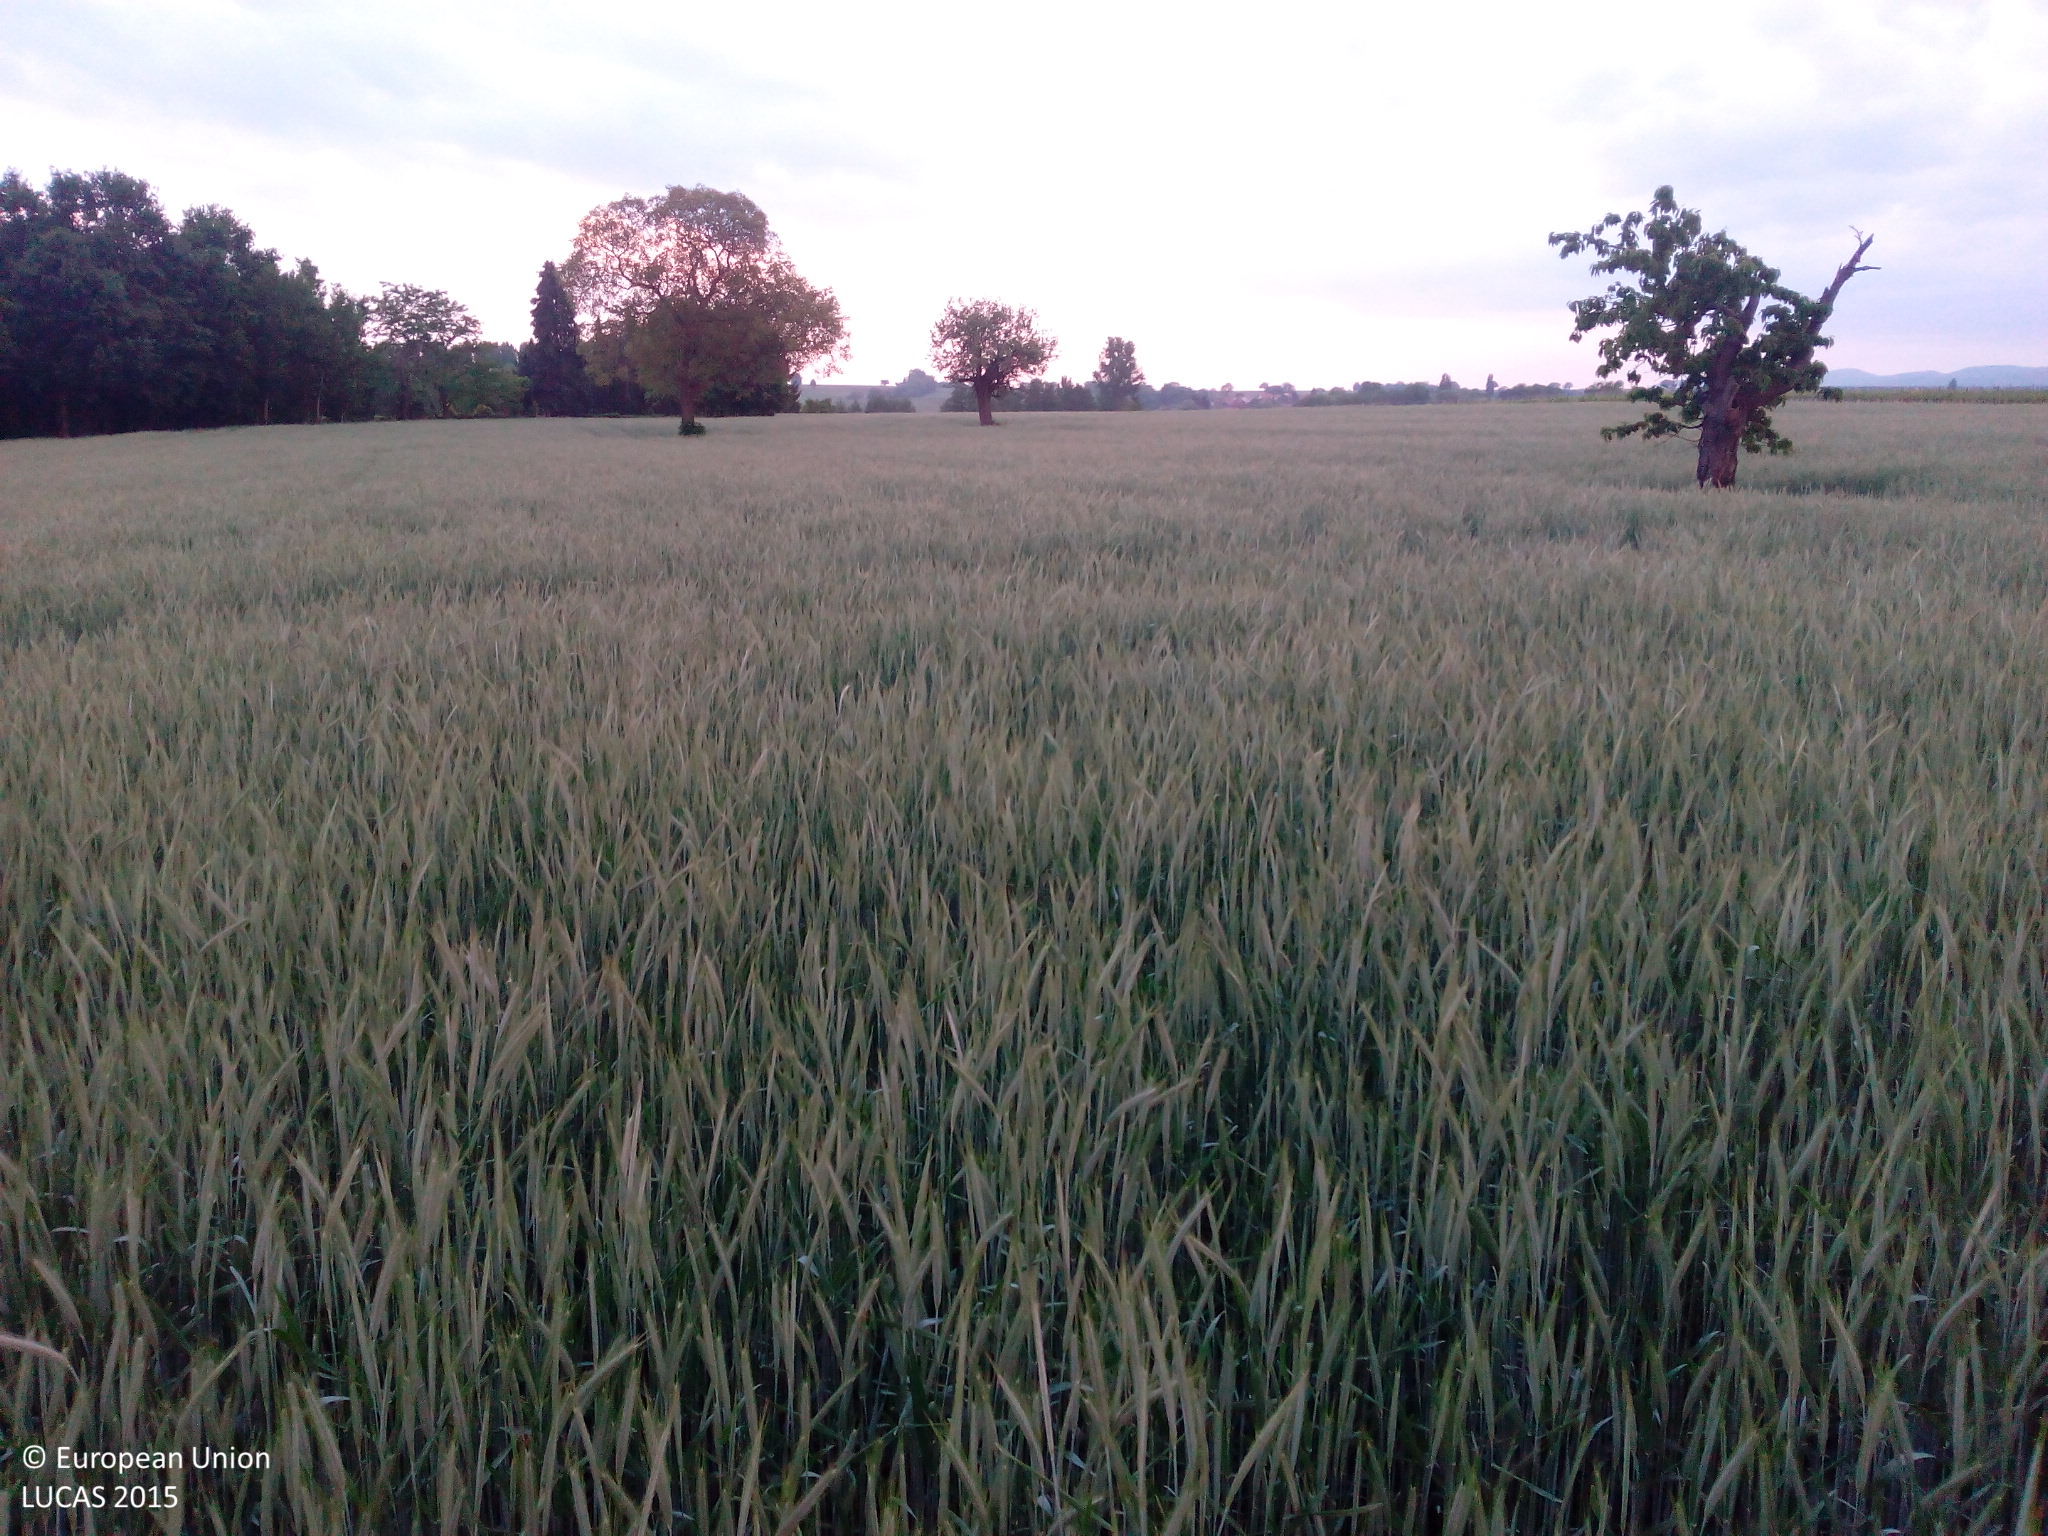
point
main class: Cropland
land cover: Rye
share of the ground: > 75 %
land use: Agriculture (excluding fallow land and kitchen gardens)
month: May
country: DE
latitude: 49.1065
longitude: 8.0692
